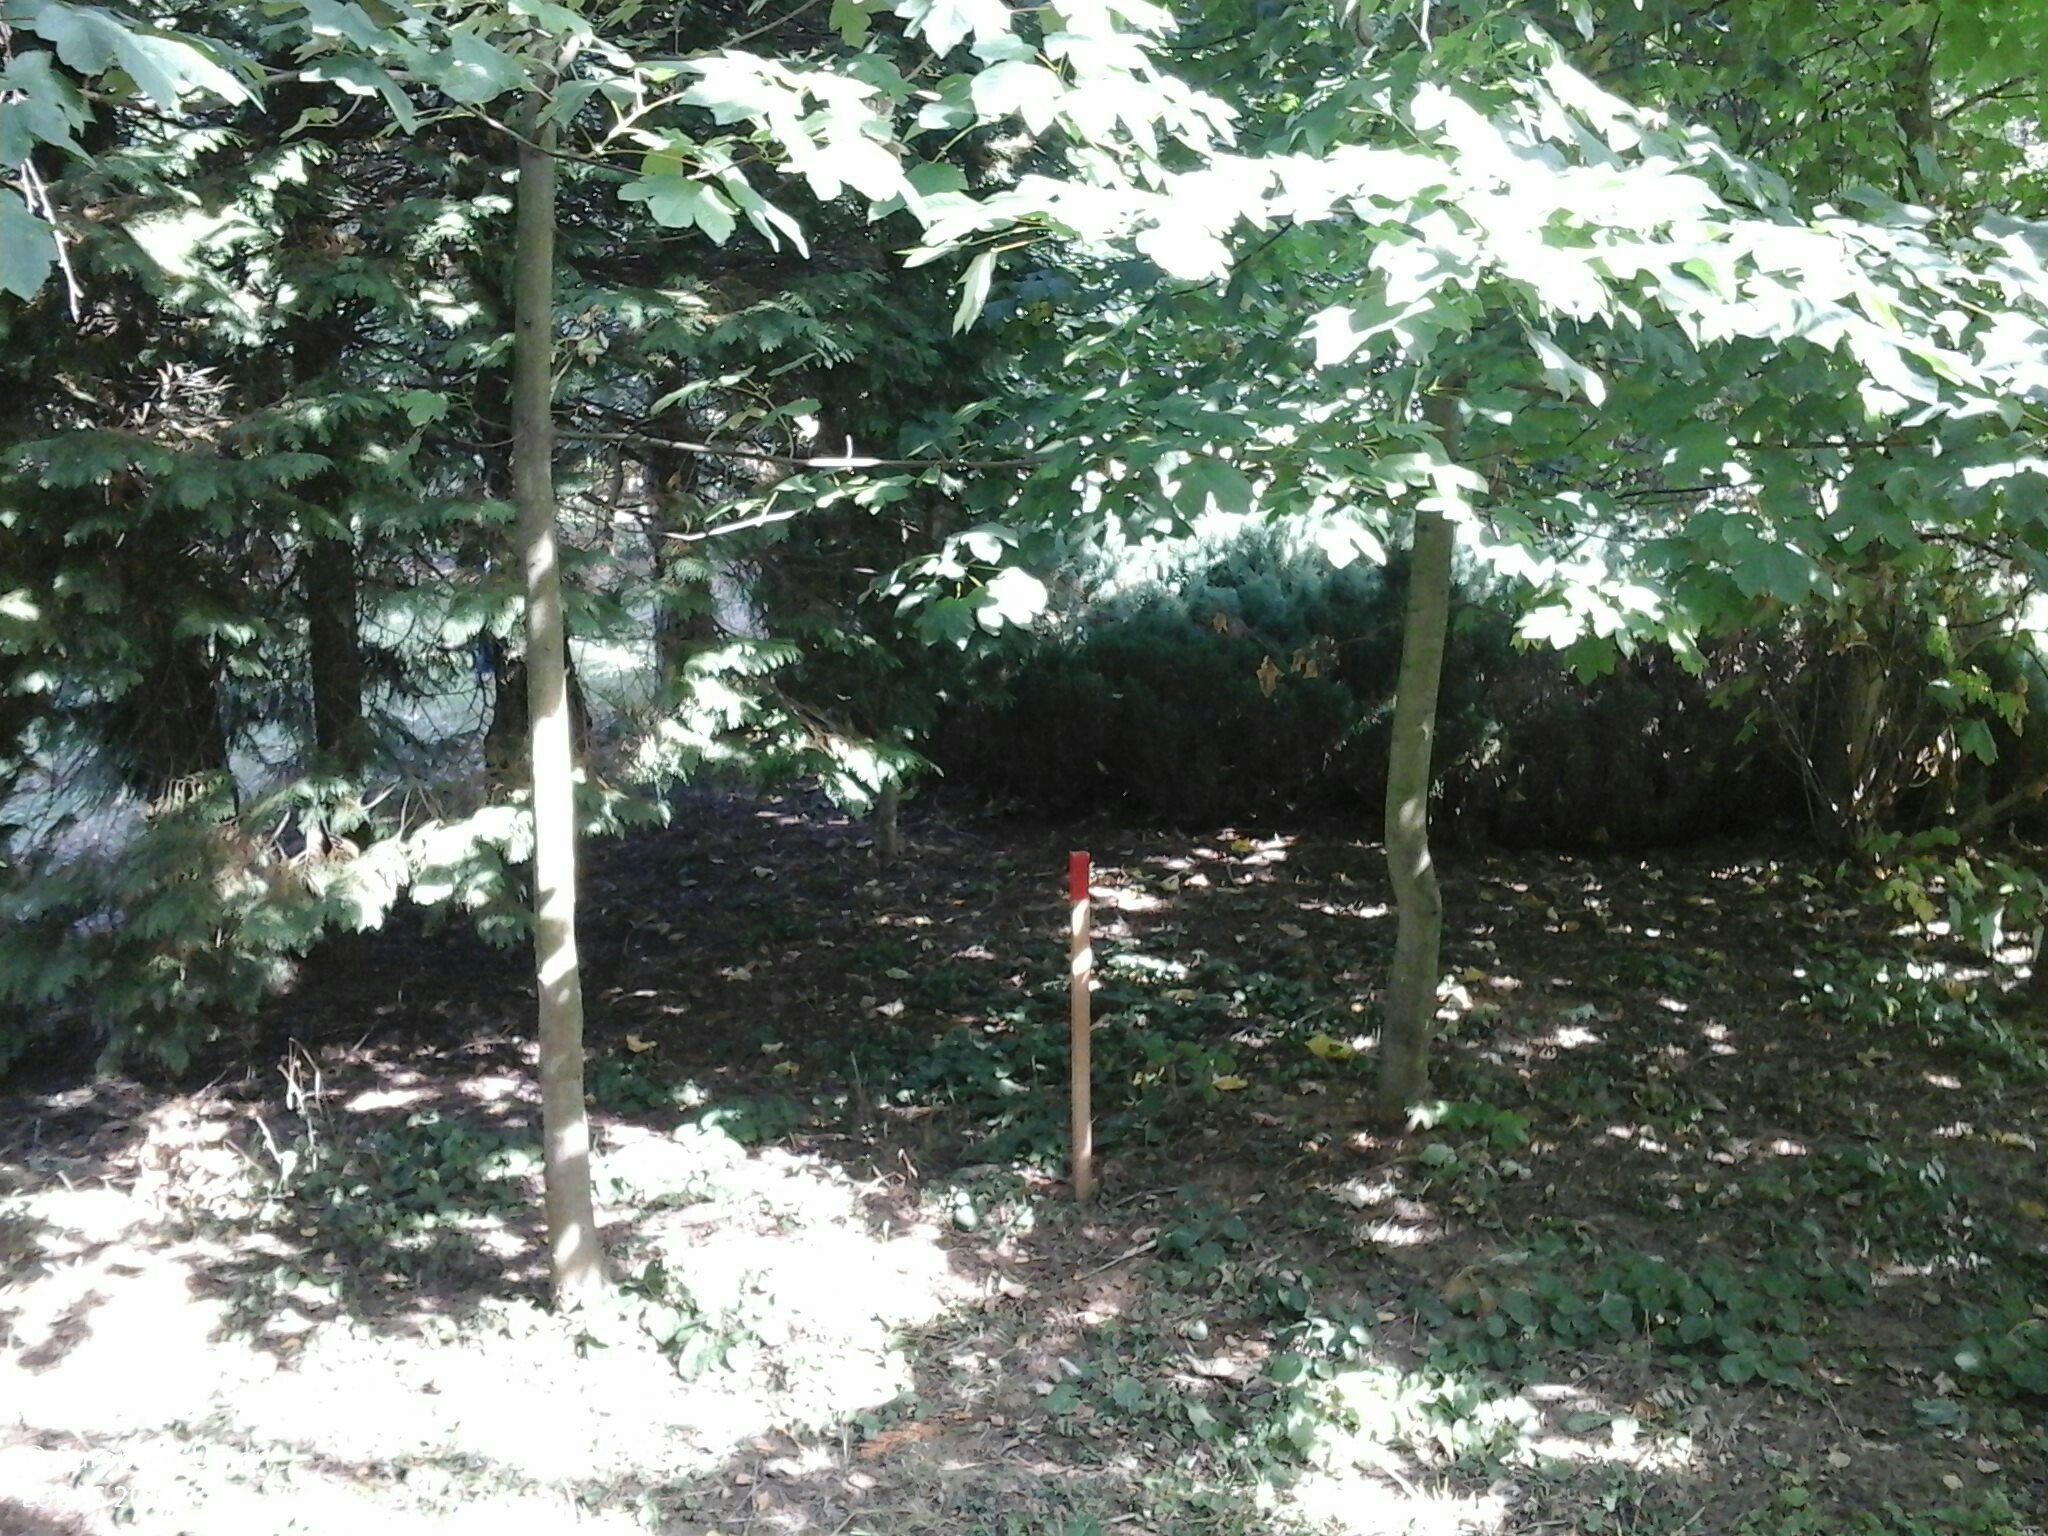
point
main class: Woodland
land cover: Broadleaved woodland
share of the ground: 50 - 75 %
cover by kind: broadleaved forest trees 70 %, herbaceous plants 25 %, coniferous forest trees 5 %
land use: Community services
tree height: > 5 m
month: August
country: HU
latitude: 46.8862
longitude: 16.6299
